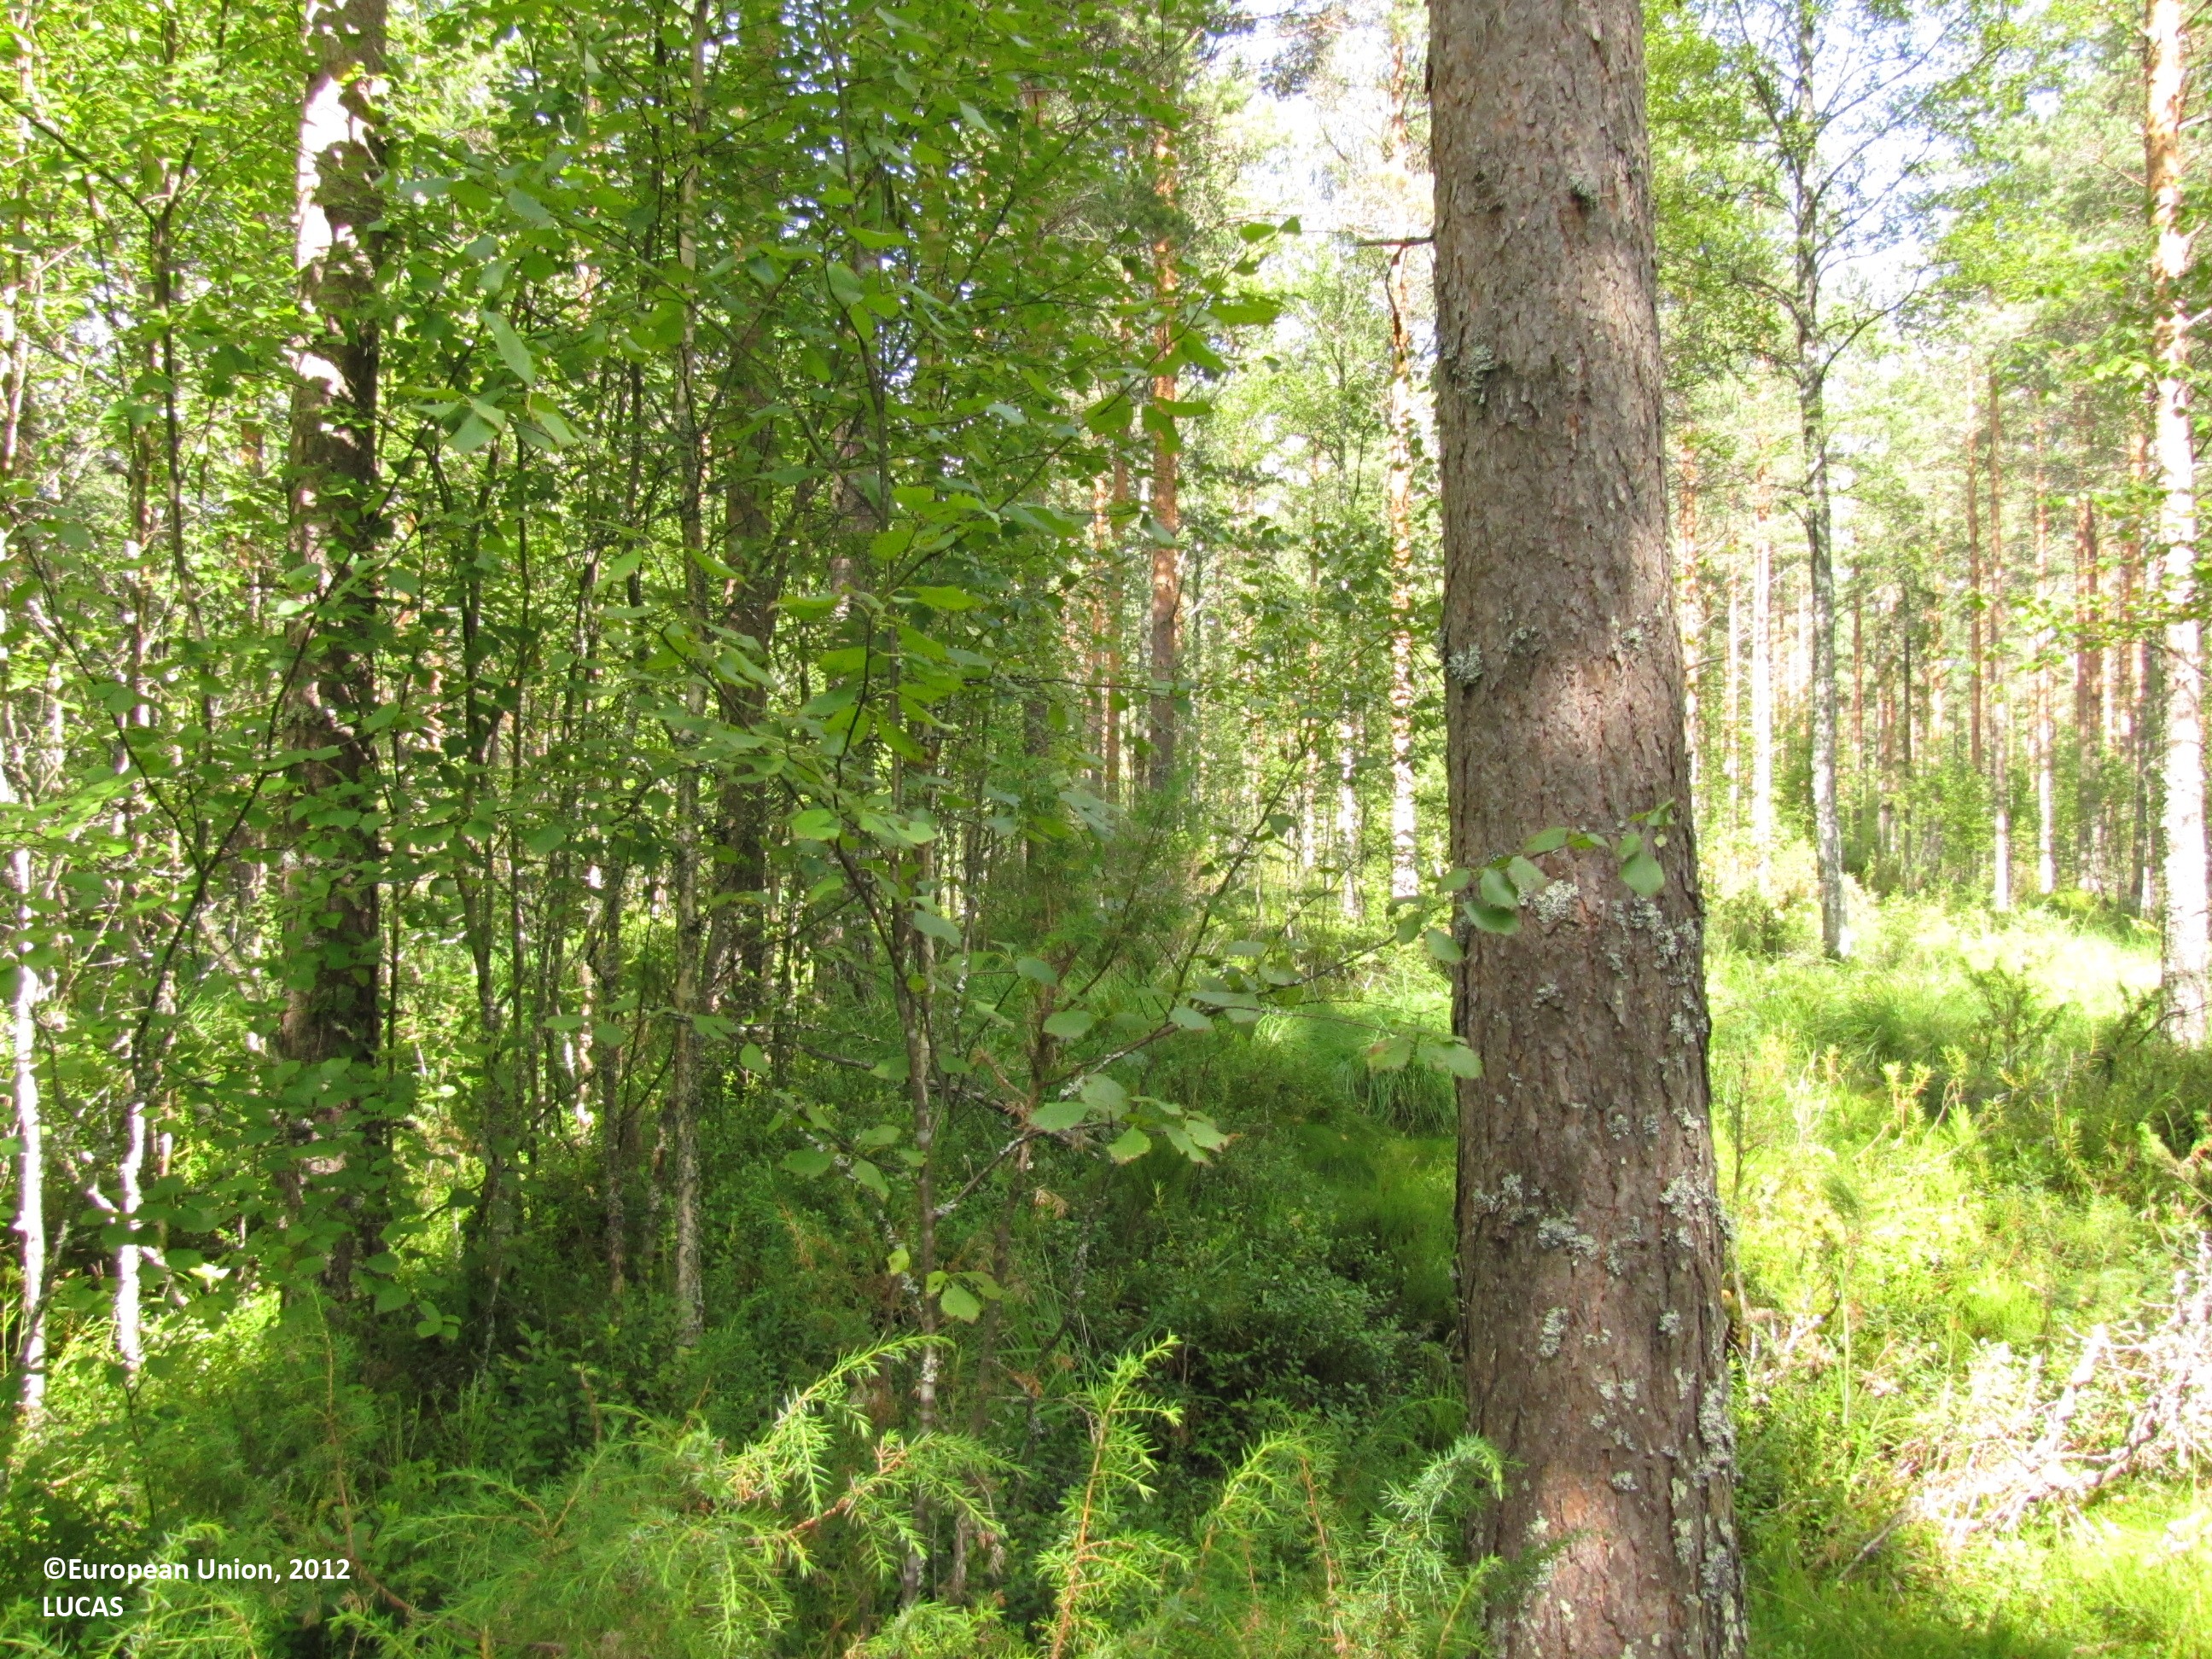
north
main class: Woodland
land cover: Pine dominated mixed woodland
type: boreal forest
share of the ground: > 75 %
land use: Forestry
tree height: > 5 m
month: August
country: FI
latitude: 61.7268
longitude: 22.8794
